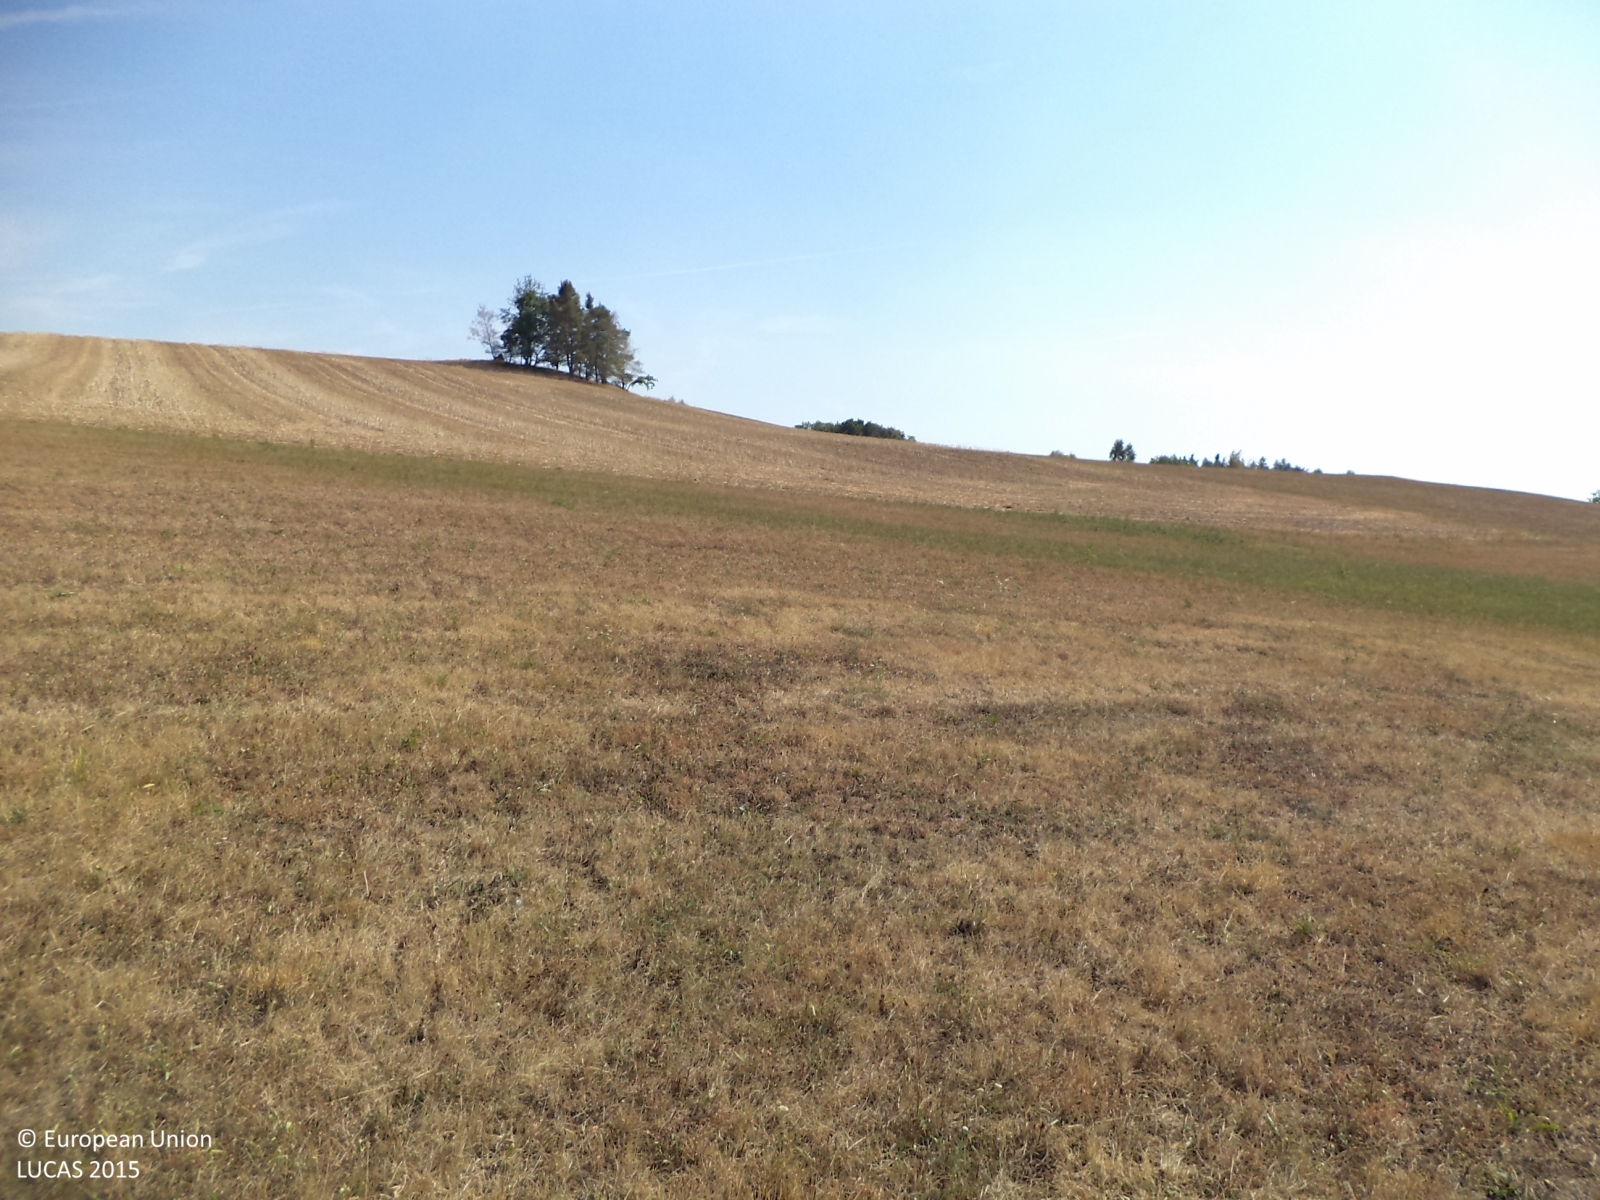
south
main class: Grassland
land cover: Grassland without tree/shrub cover
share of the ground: > 75 %
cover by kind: herbaceous plants 100 %
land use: Agriculture (excluding fallow land and kitchen gardens)
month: August
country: CZ
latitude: 49.6282
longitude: 14.4732
